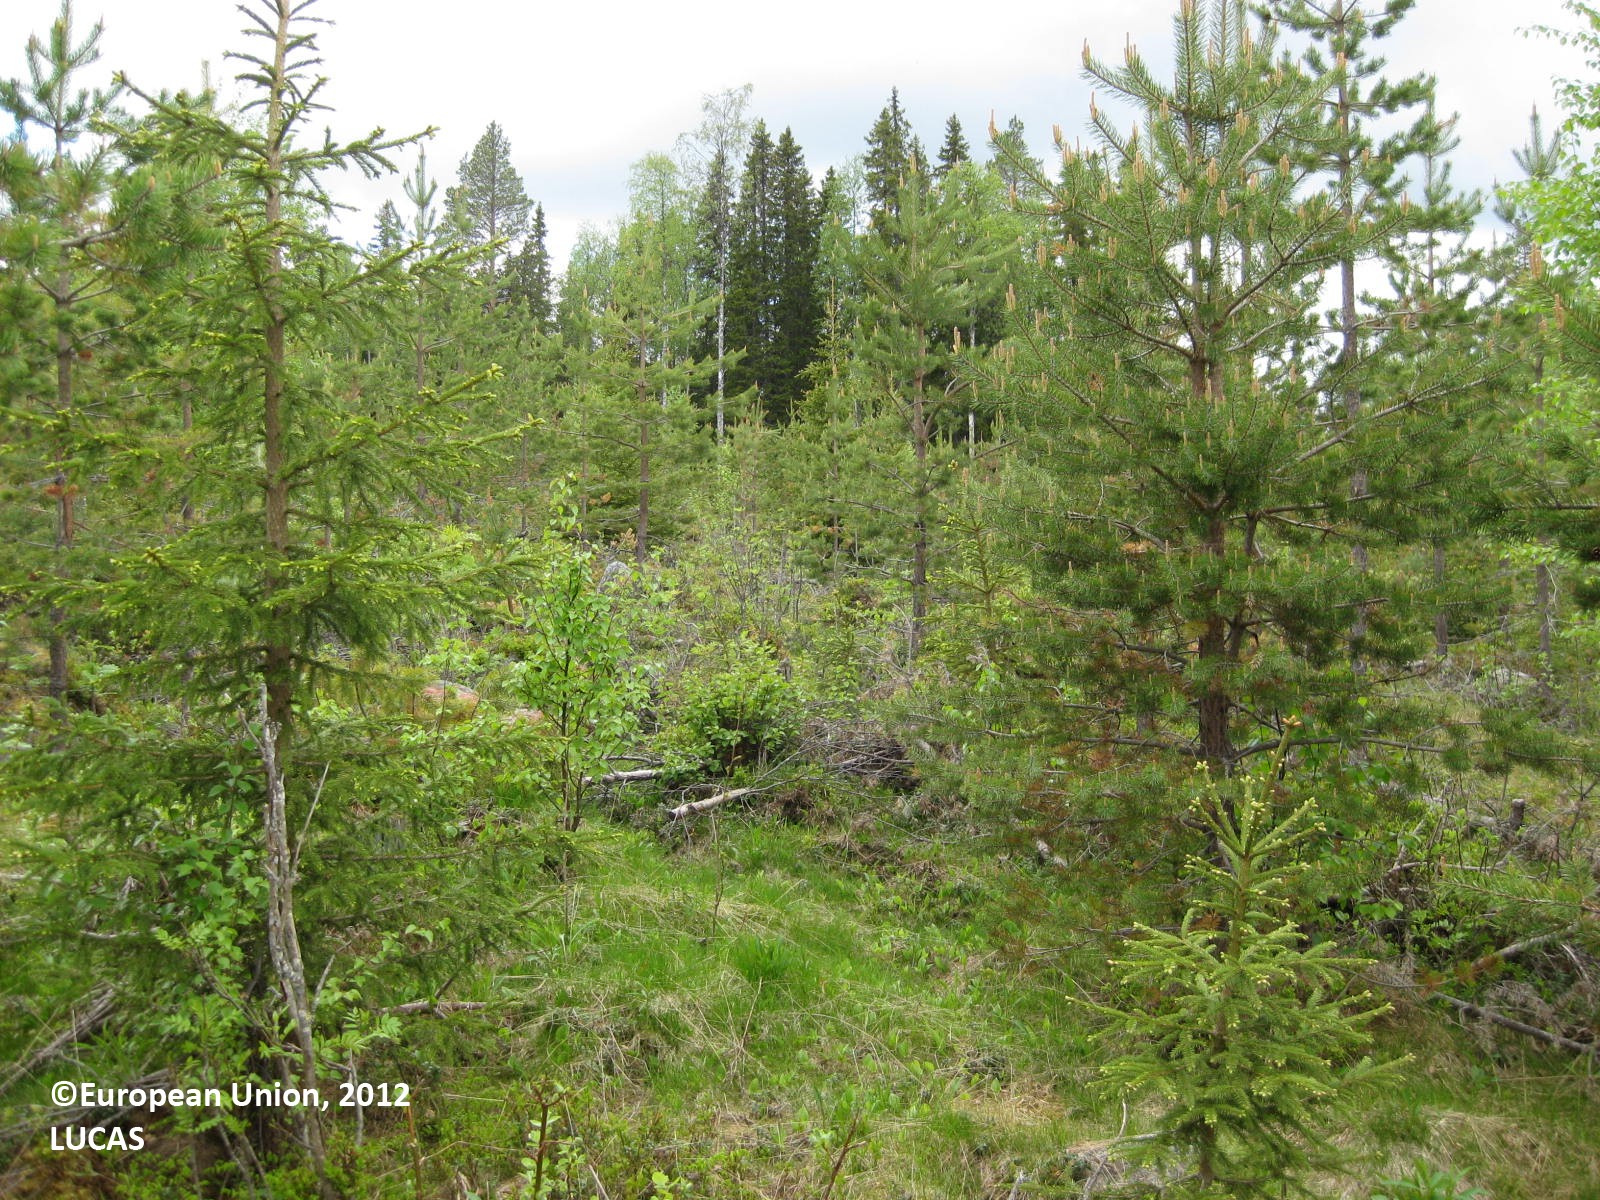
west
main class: Woodland
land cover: Pine dominated mixed woodland
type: boreal forest
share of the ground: 50 - 75 %
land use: Forestry
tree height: < 5 m
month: June
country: FI
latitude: 65.2240
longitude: 28.9366
